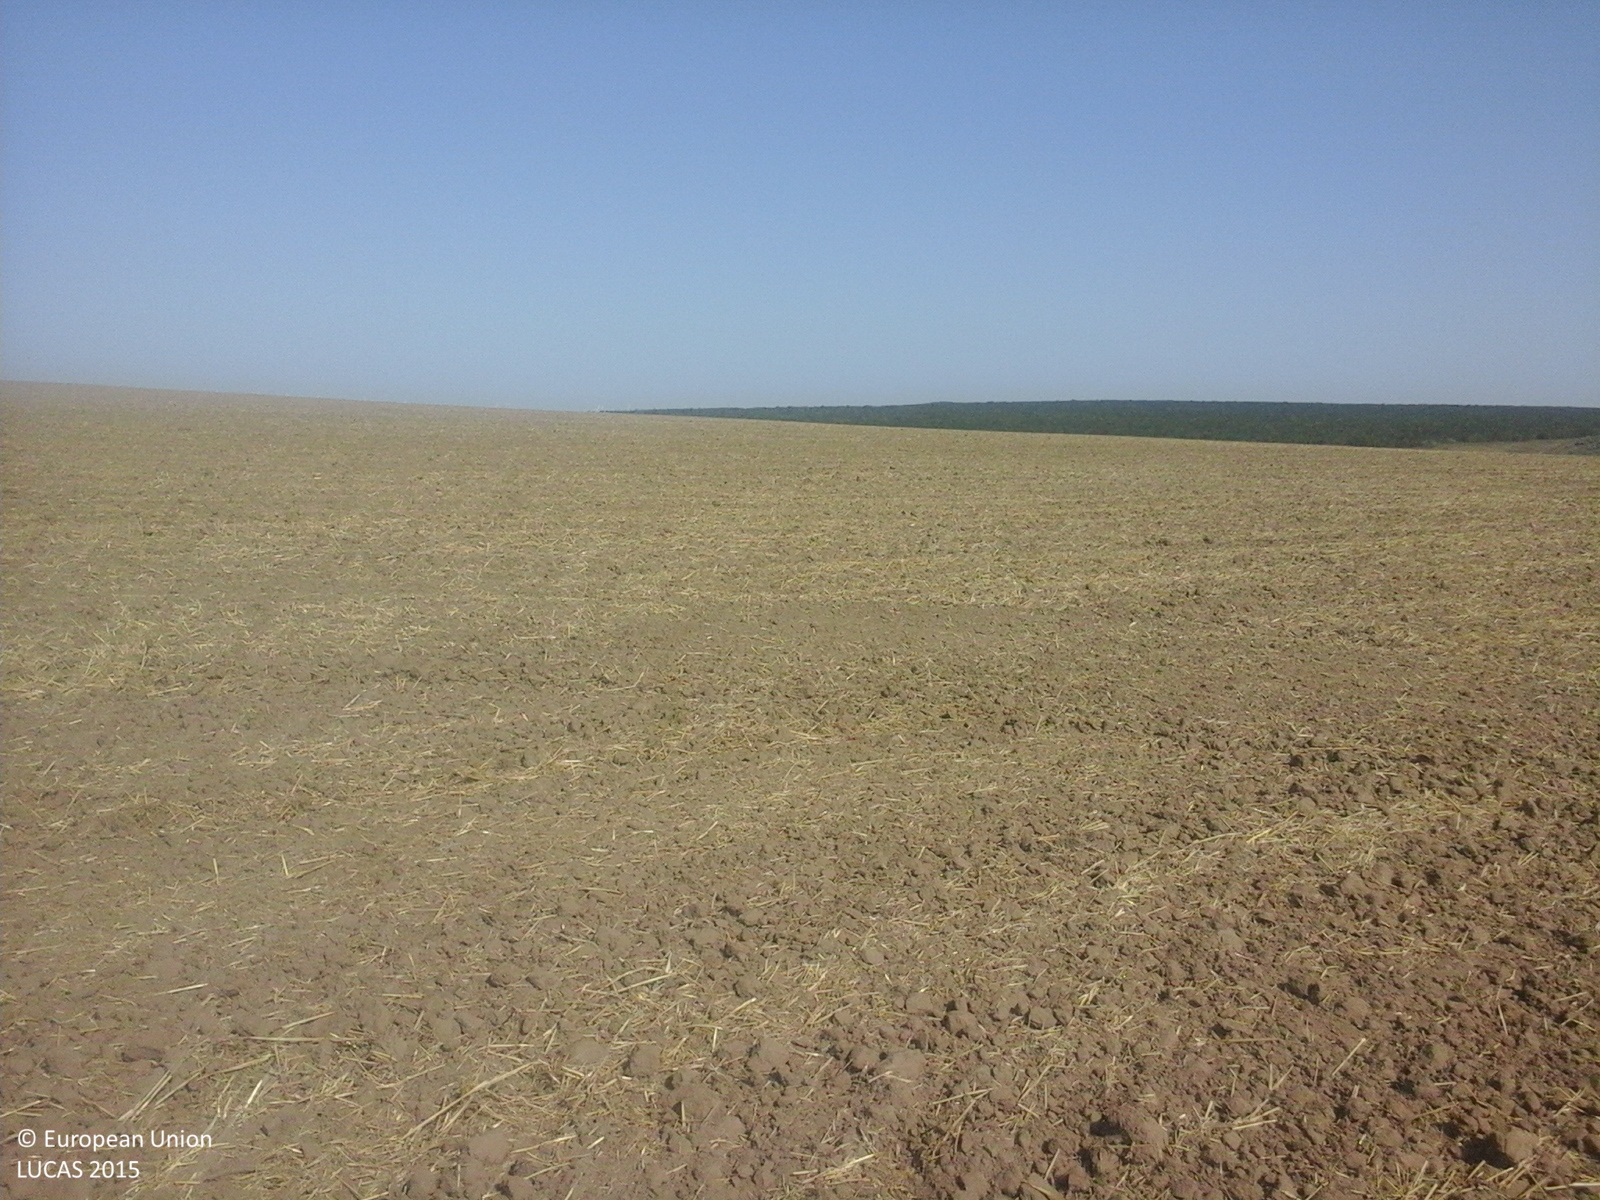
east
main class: Cropland
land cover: Common wheat
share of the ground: < 10 %
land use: Agriculture (excluding fallow land and kitchen gardens)
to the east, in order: Common wheat
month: August
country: RO
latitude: 44.5854
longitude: 28.1107
